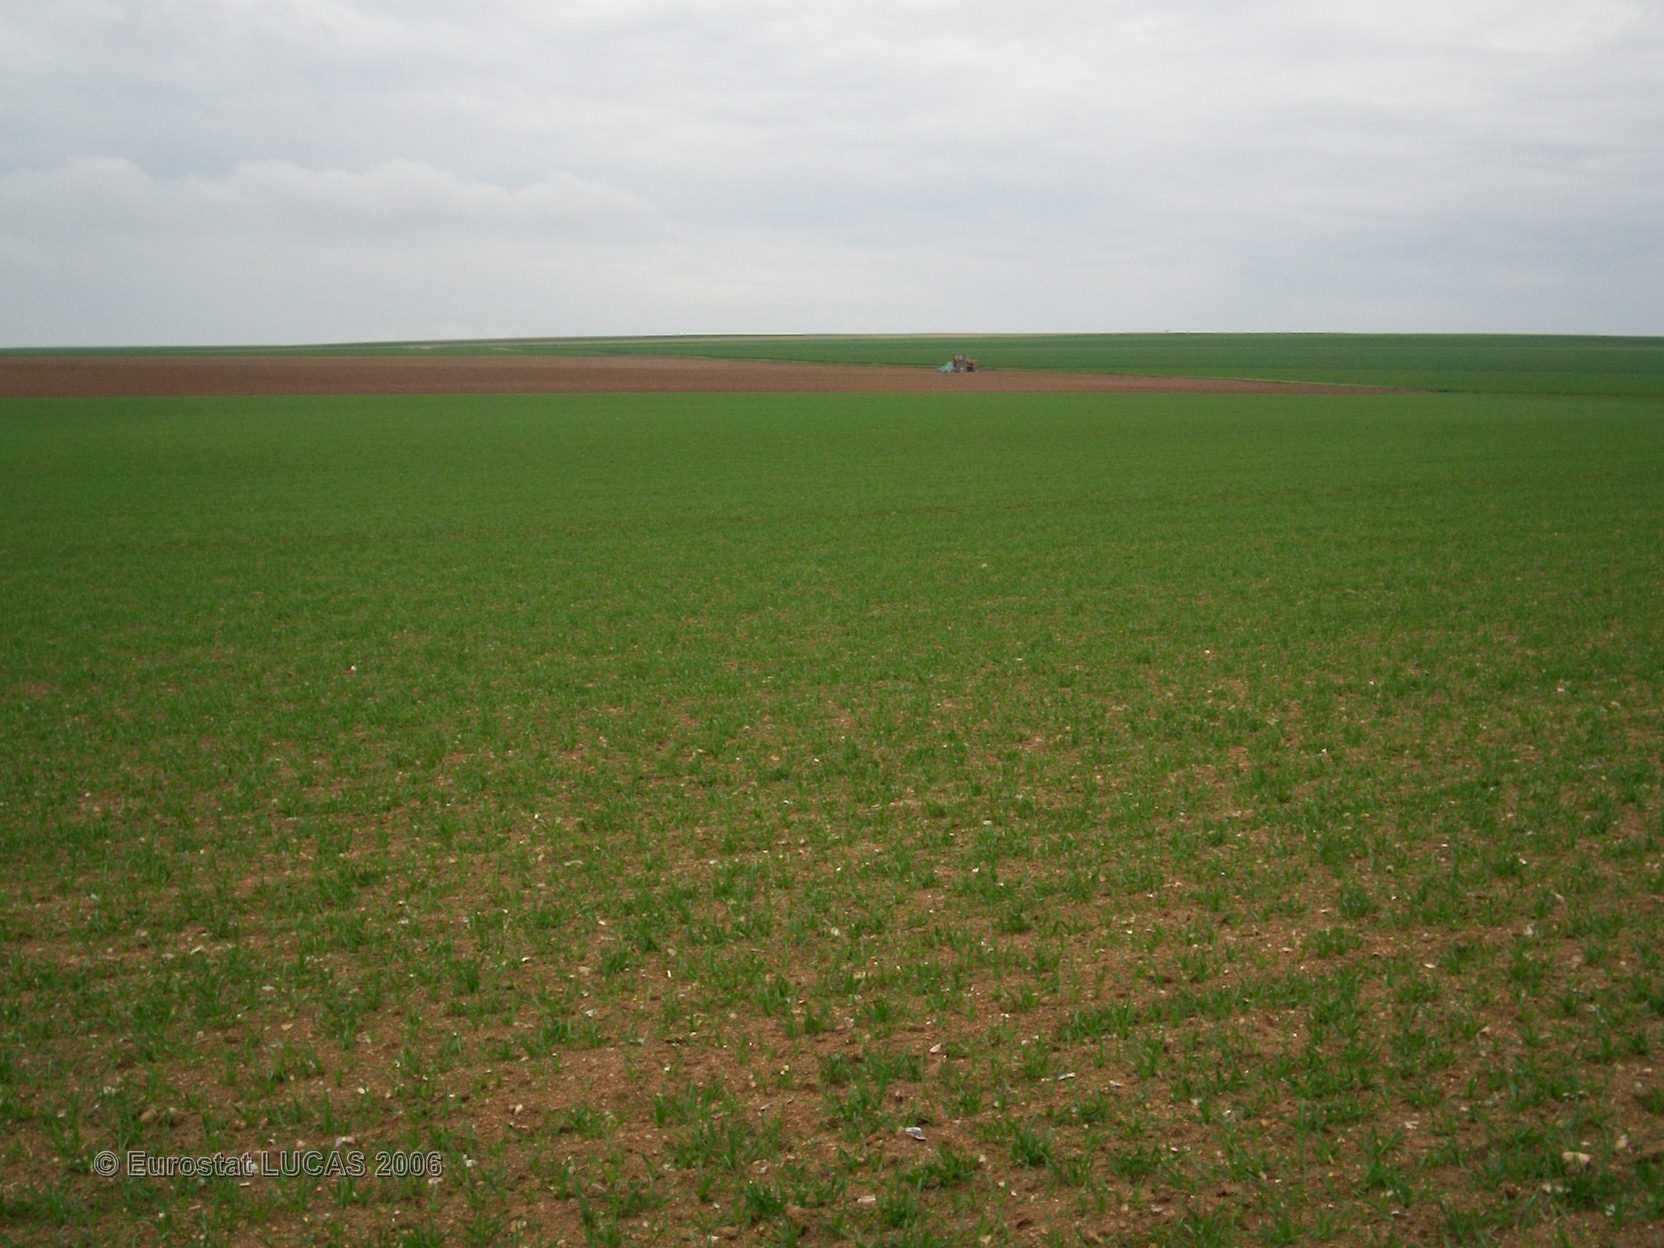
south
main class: Cropland
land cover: Barley
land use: Agriculture (excluding fallow land and kitchen gardens)
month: April
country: FR
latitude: 48.4559
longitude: 3.9785
